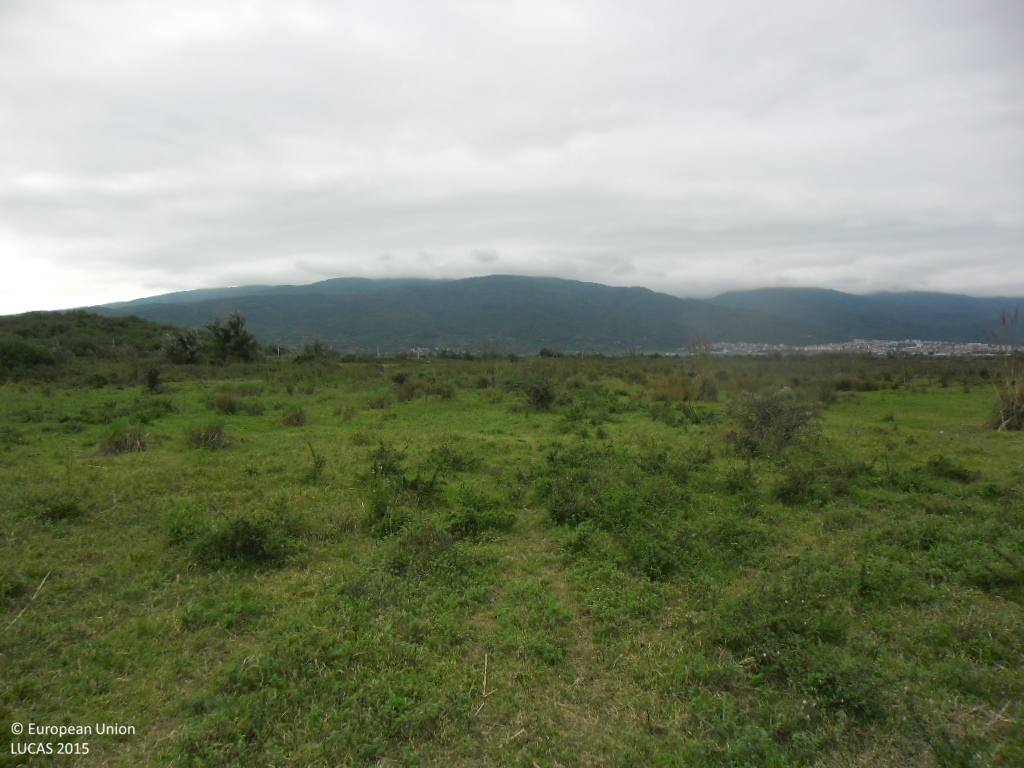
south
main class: Grassland
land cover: Grassland without tree/shrub cover
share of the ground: > 75 %
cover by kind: herbaceous plants 100 %
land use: Agriculture (excluding fallow land and kitchen gardens)
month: September
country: BG
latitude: 41.4328
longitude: 23.2436
